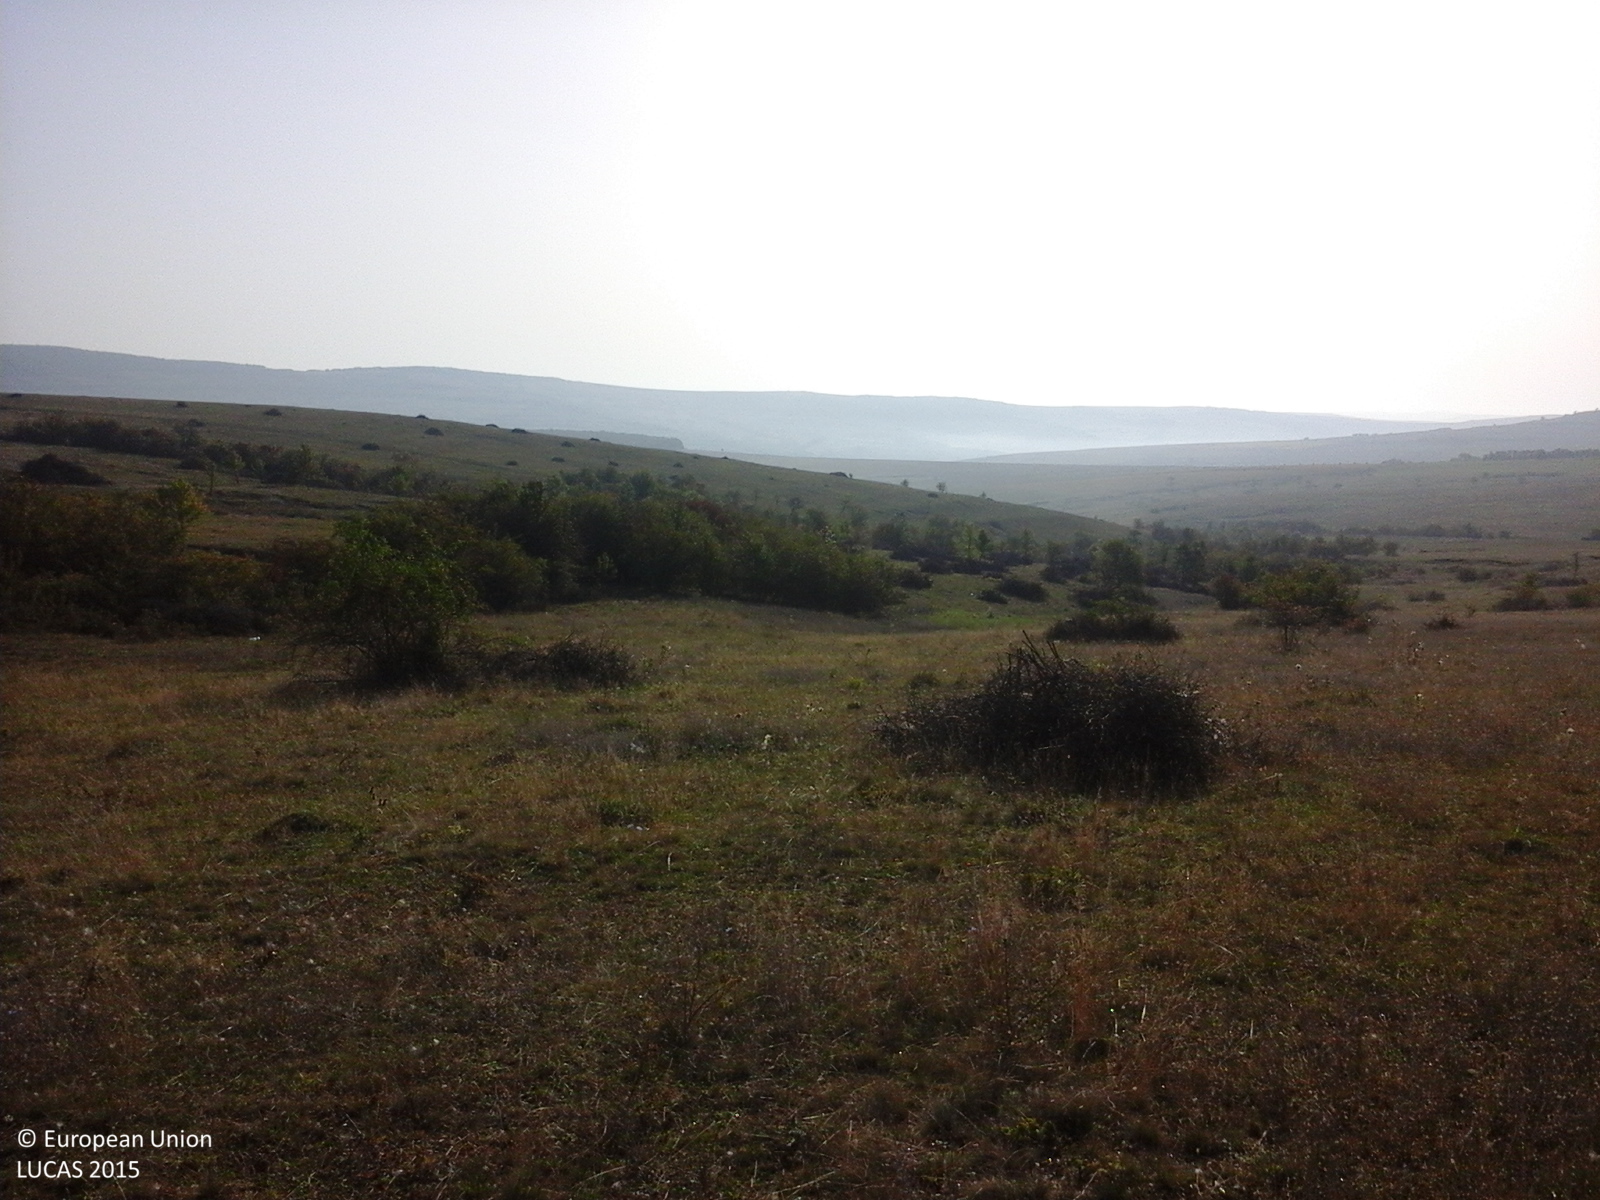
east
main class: Grassland
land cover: Grassland without tree/shrub cover
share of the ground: > 75 %
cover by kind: herbaceous plants 100 %
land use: Agriculture (excluding fallow land and kitchen gardens)
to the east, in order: Grassland without tree/shrub cover; Shrubland without tree cover
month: September
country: RO
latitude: 47.0530
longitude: 23.6997
